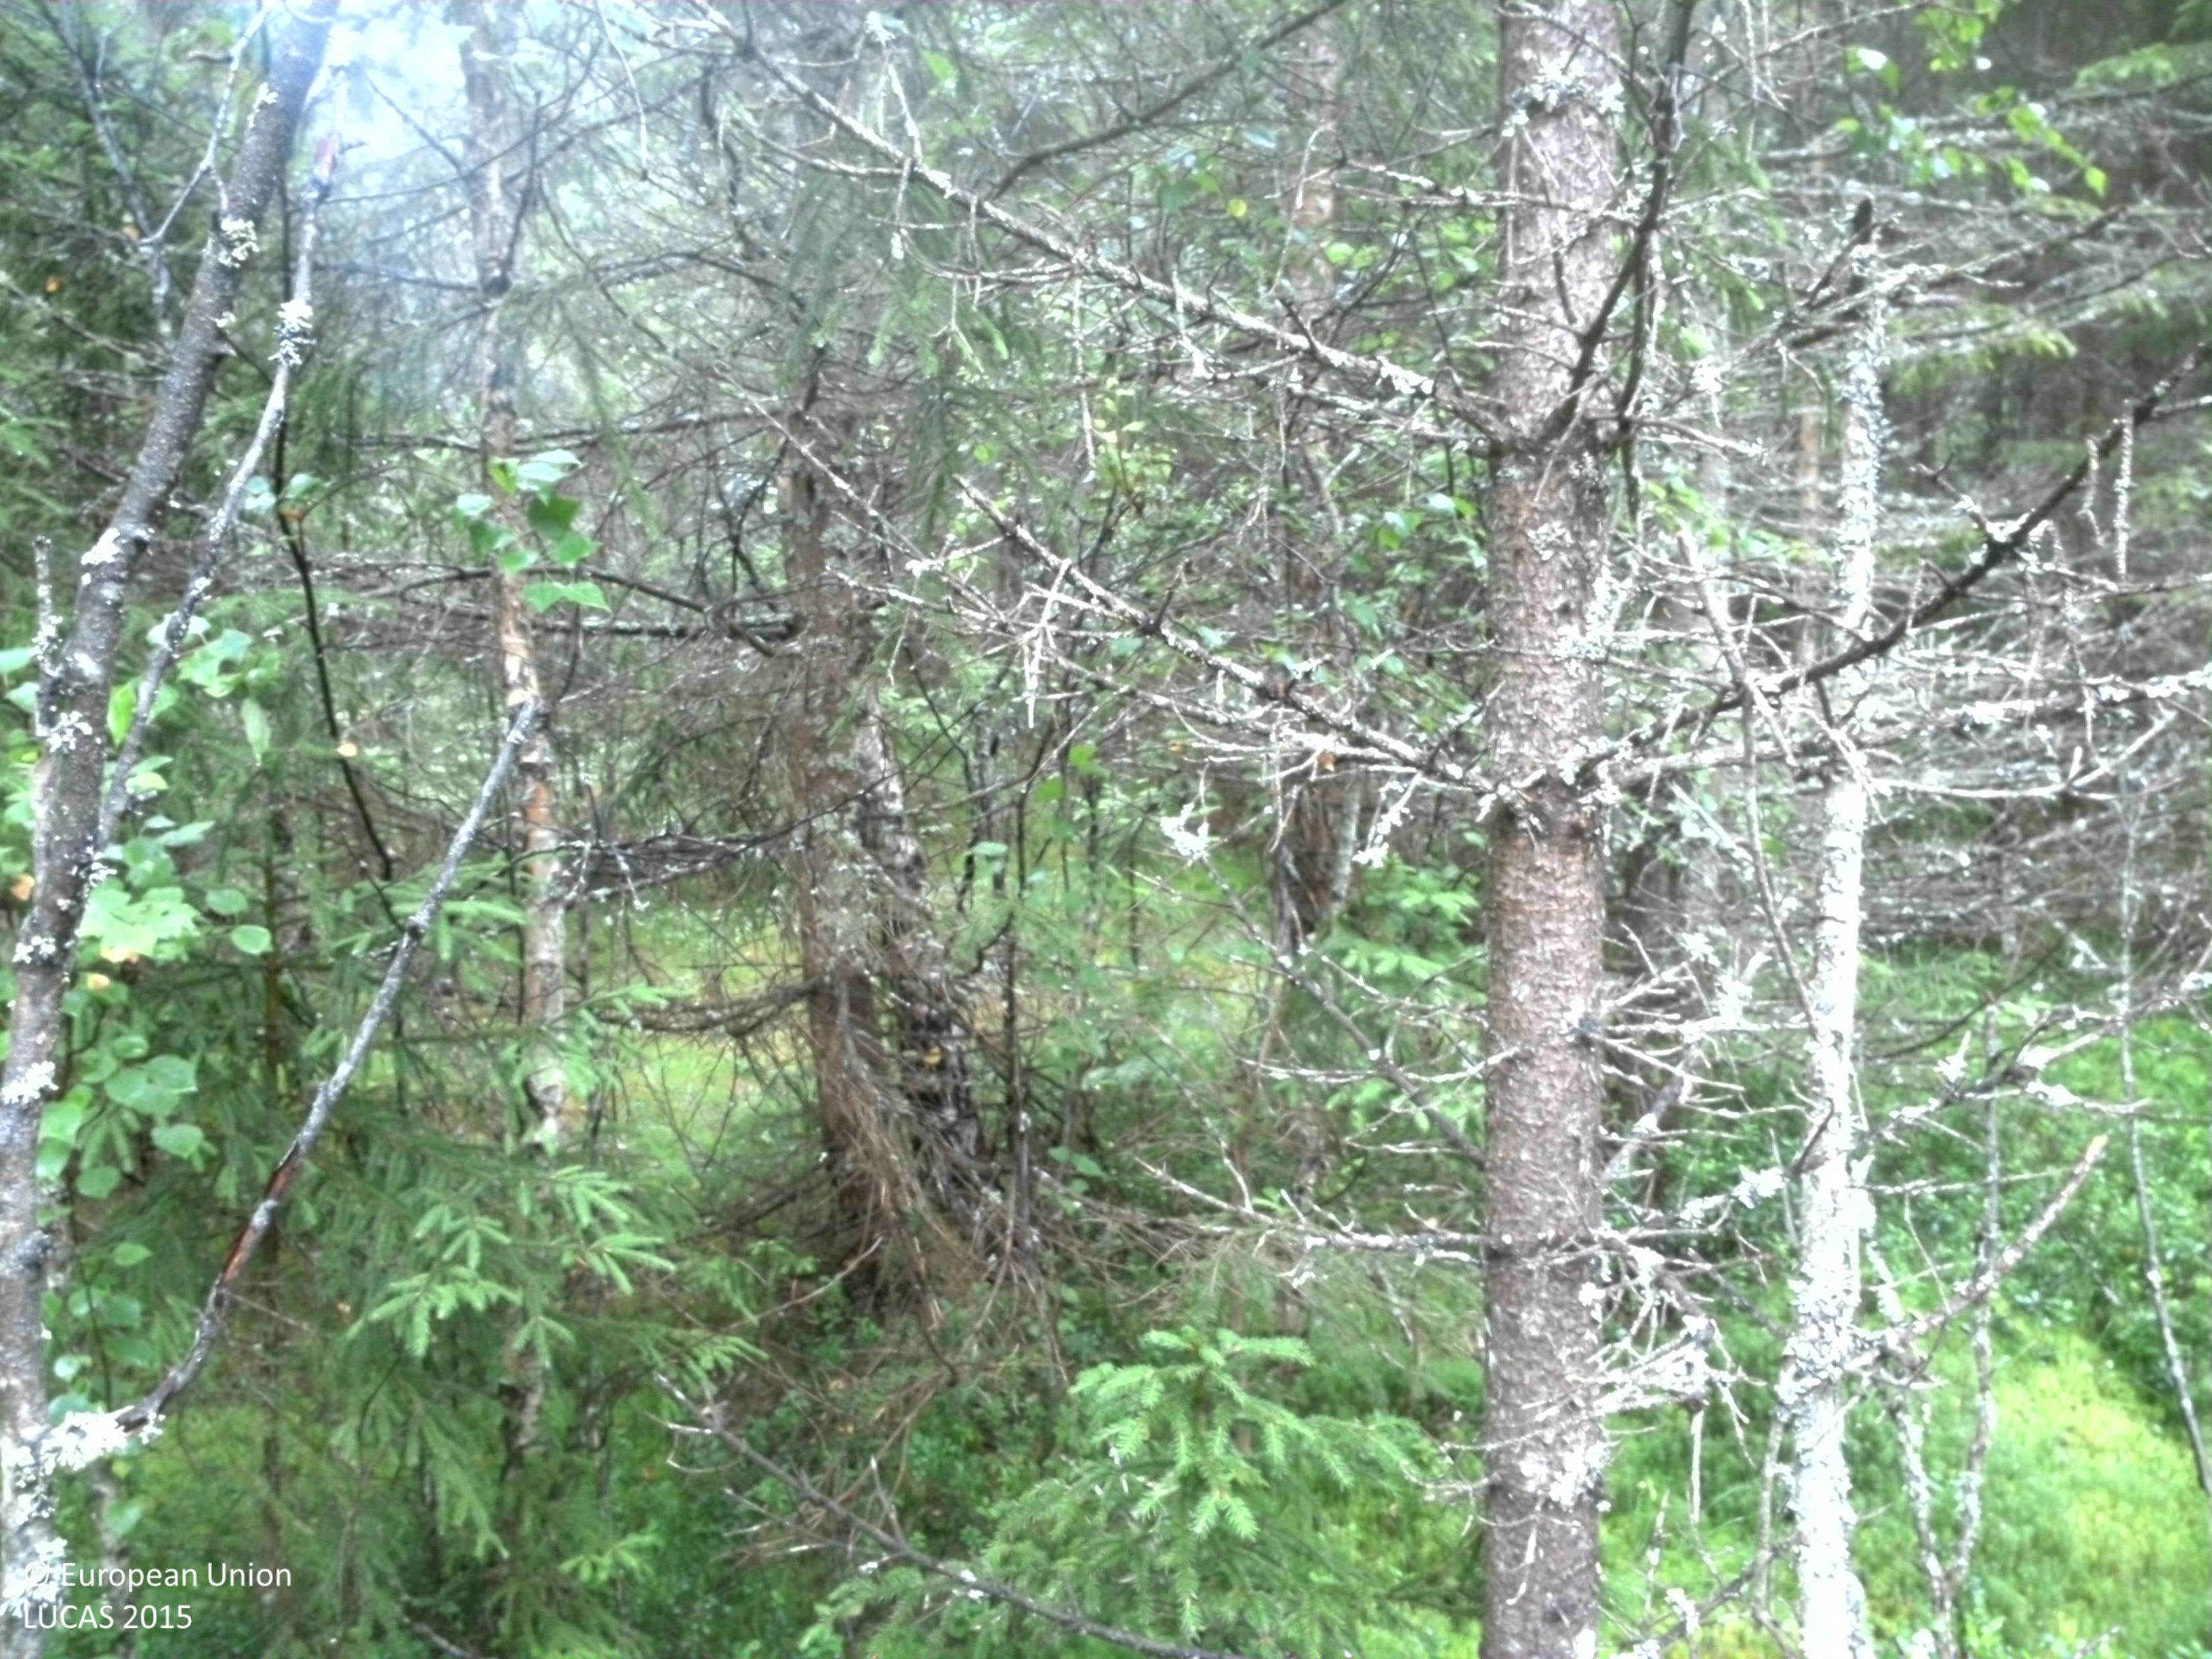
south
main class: Woodland
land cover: Other mixed woodland
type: boreal forest
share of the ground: 50 - 75 %
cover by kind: coniferous forest trees 45 %, broadleaved forest trees 20 %, lichens and mosses 15 %, shrubs 10 %, herbaceous plants 10 %
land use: Forestry
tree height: > 5 m
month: July
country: SE
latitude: 59.2725
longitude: 14.7115
